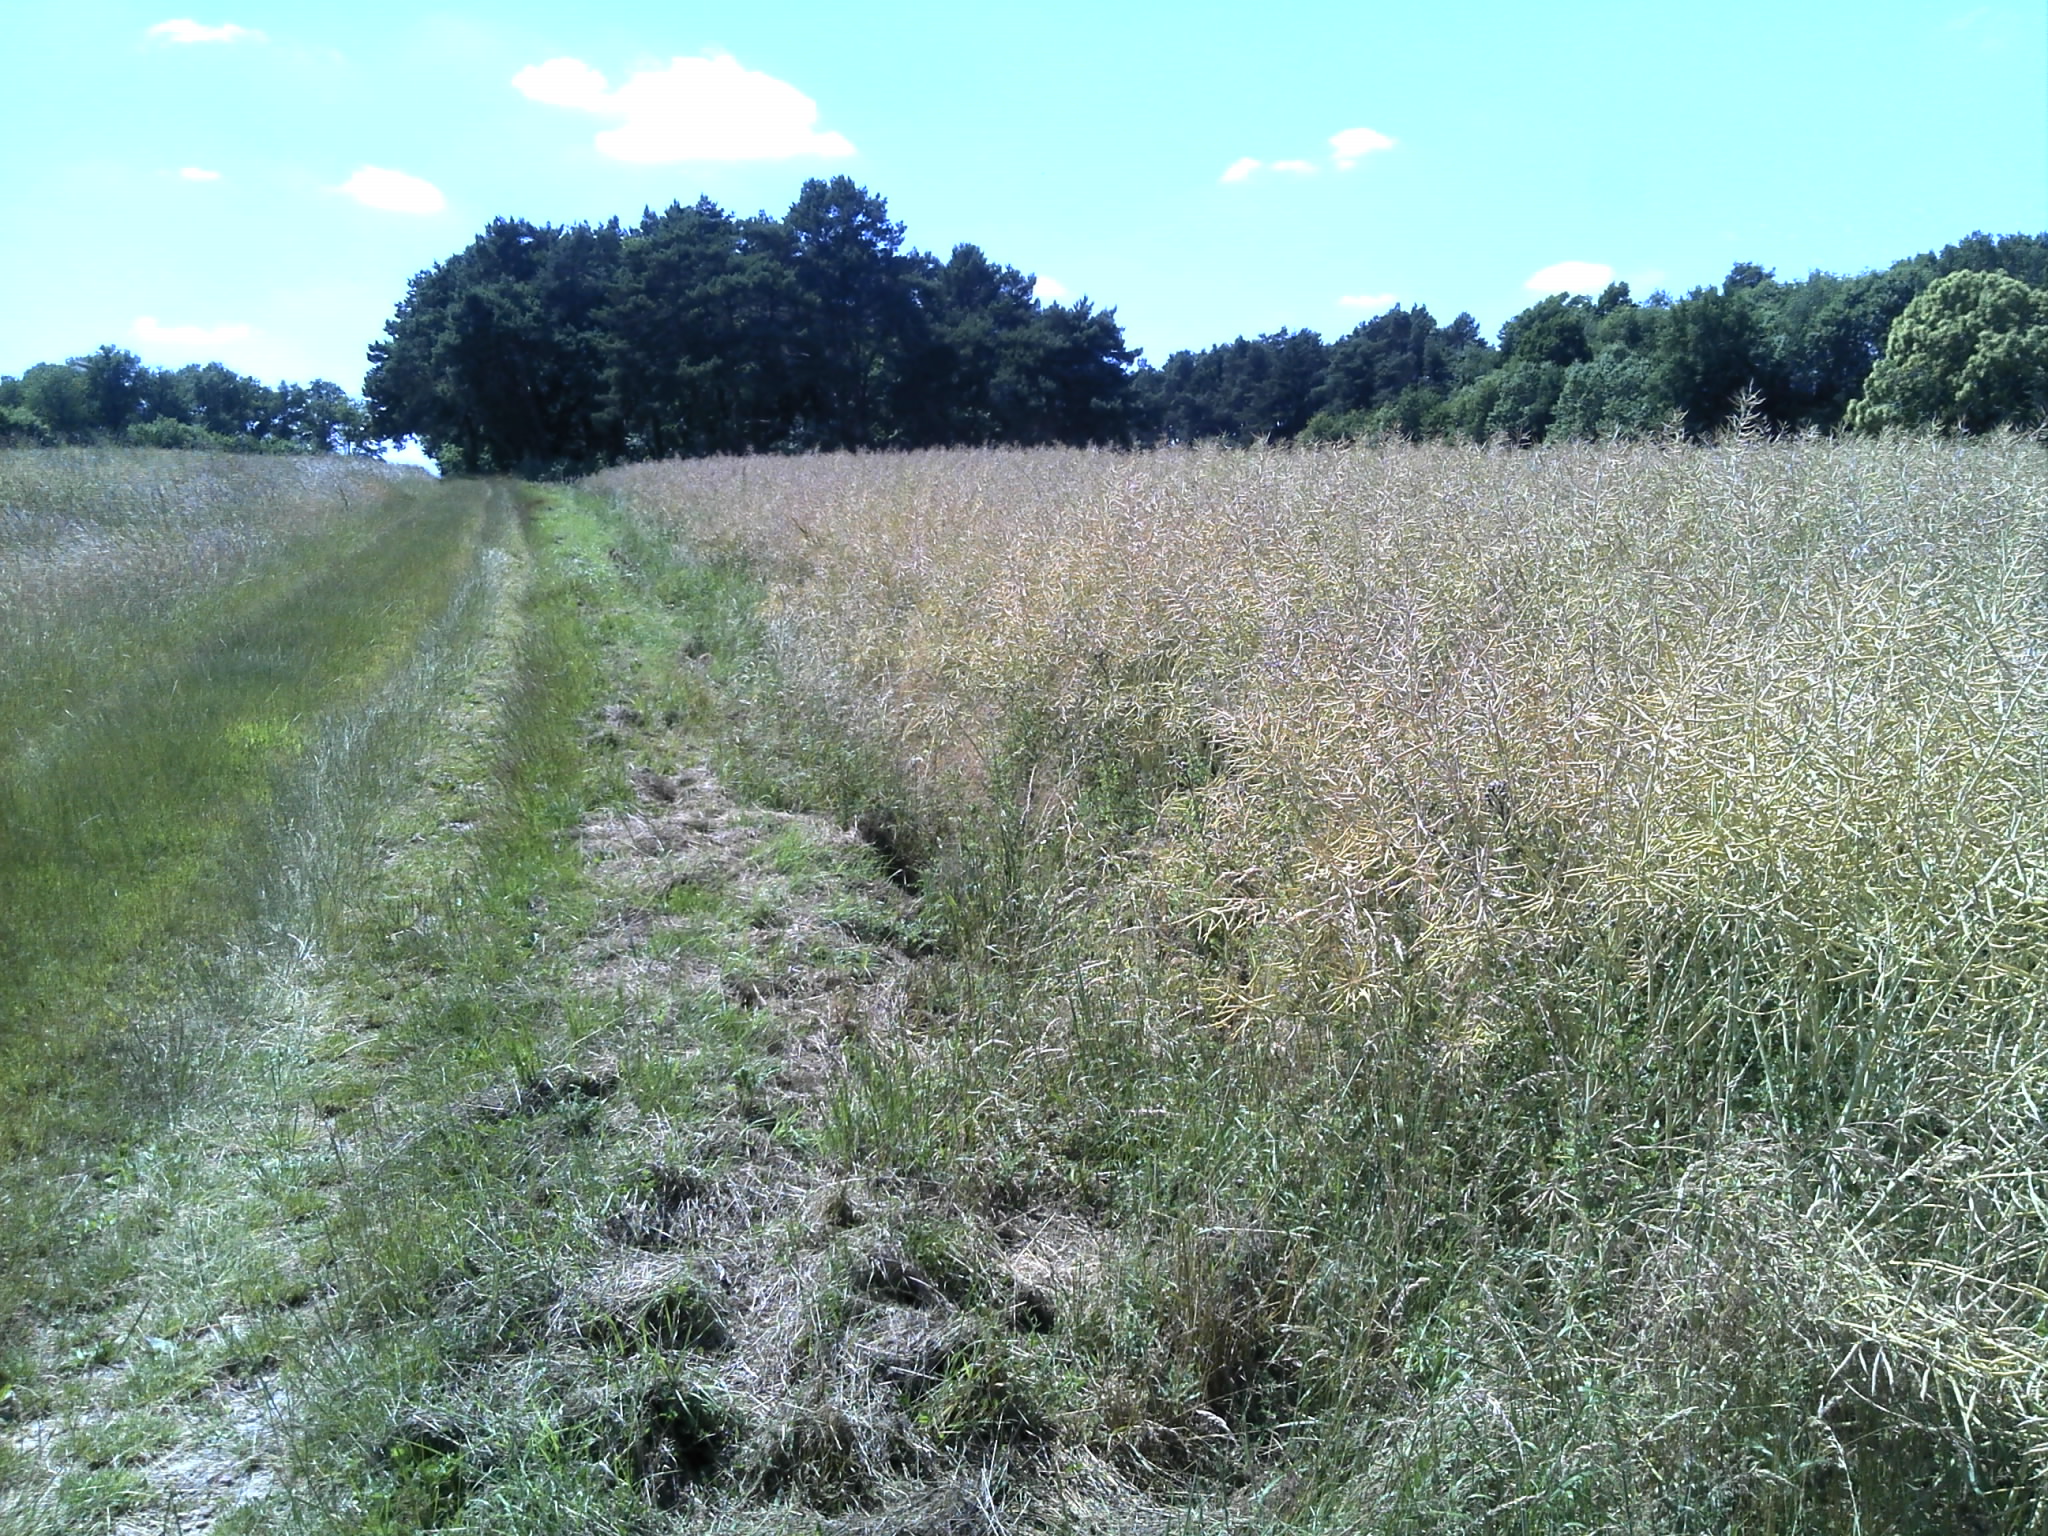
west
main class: Cropland
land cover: Rape and turnip rape
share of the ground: > 75 %
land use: Agriculture (excluding fallow land and kitchen gardens)
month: June
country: FR
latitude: 47.1115
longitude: 1.4342
